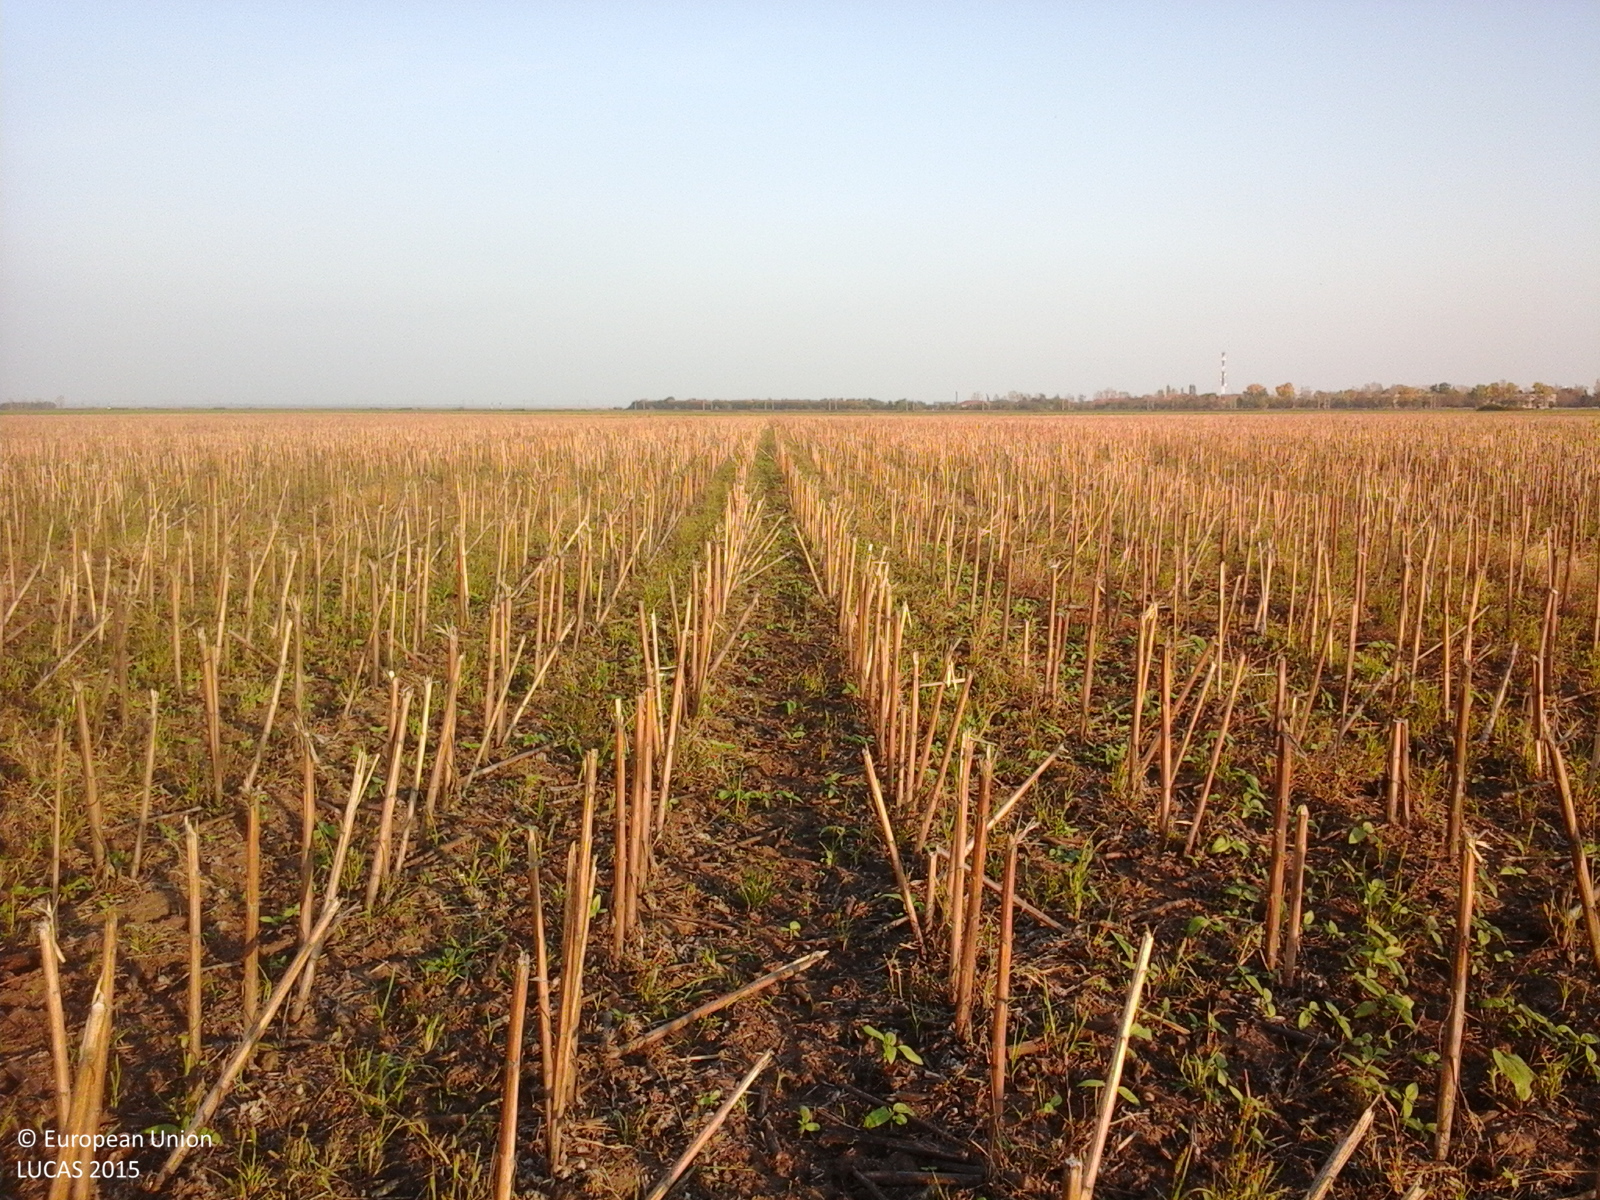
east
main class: Cropland
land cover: Sunflower
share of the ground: 25 - 50 %
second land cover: Spontaneously vegetated surfaces
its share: 25 - 50 %
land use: Agriculture (excluding fallow land and kitchen gardens)
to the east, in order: Sunflower; Spontaneously vegetated surfaces
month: October
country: RO
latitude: 45.2274
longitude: 26.9338
